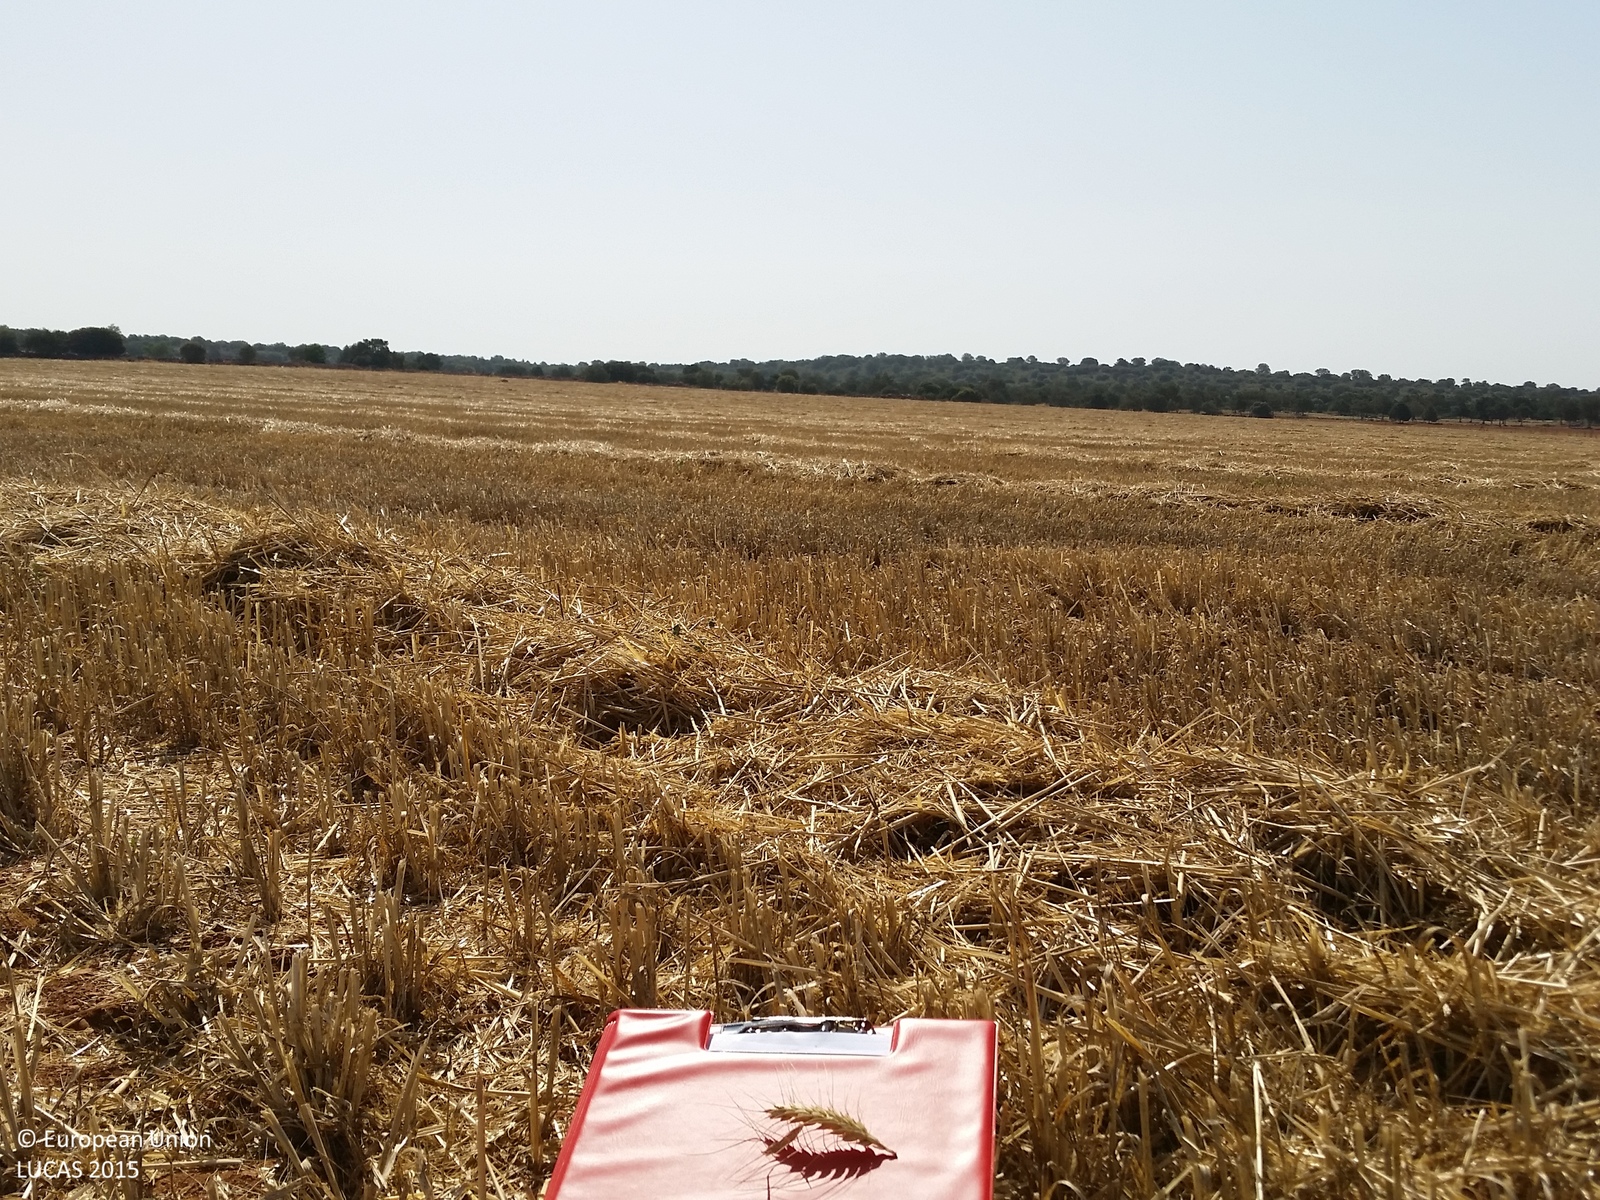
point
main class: Cropland
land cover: Common wheat
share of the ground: < 10 %
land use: Agriculture (excluding fallow land and kitchen gardens)
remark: Harvested field
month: July
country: ES
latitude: 38.9460
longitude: -2.6868
